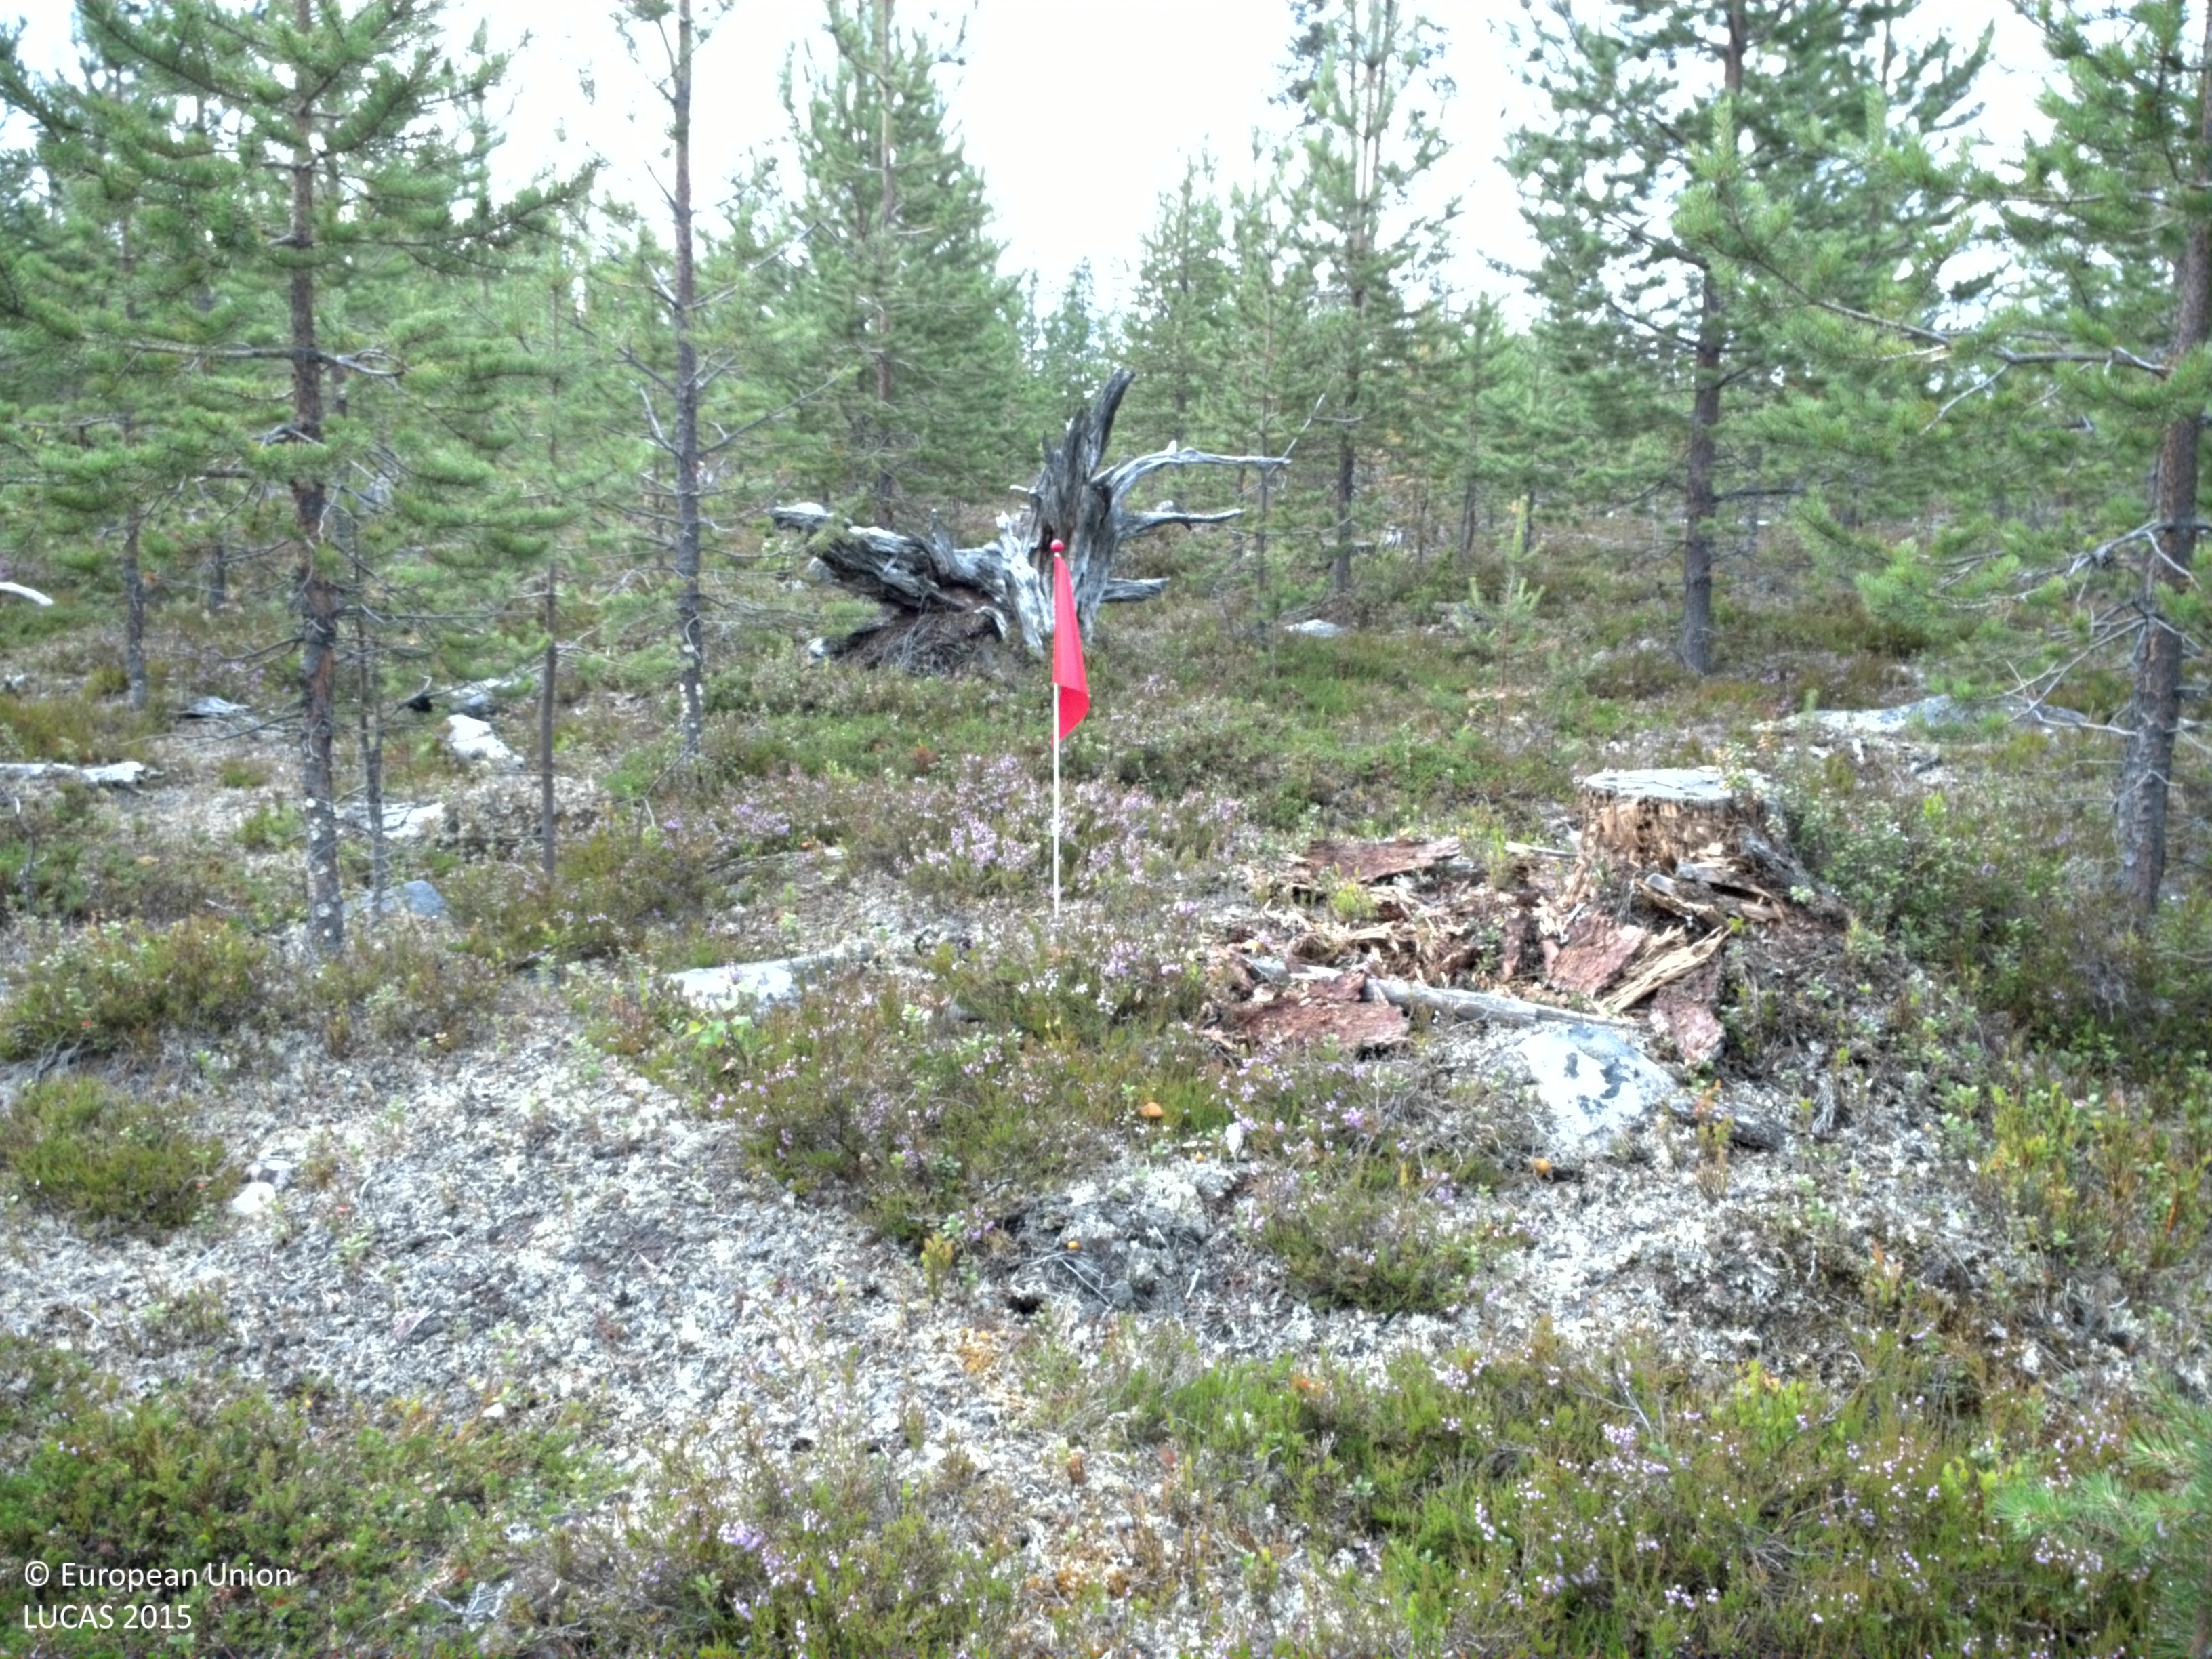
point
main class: Woodland
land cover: Pine dominated coniferous woodland
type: boreal forest
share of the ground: 25 - 50 %
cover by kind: shrubs 55 %, coniferous forest trees 30 %, lichens and mosses 15 %
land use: Forestry
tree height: > 5 m
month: August
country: SE
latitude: 66.3343
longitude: 20.4734
